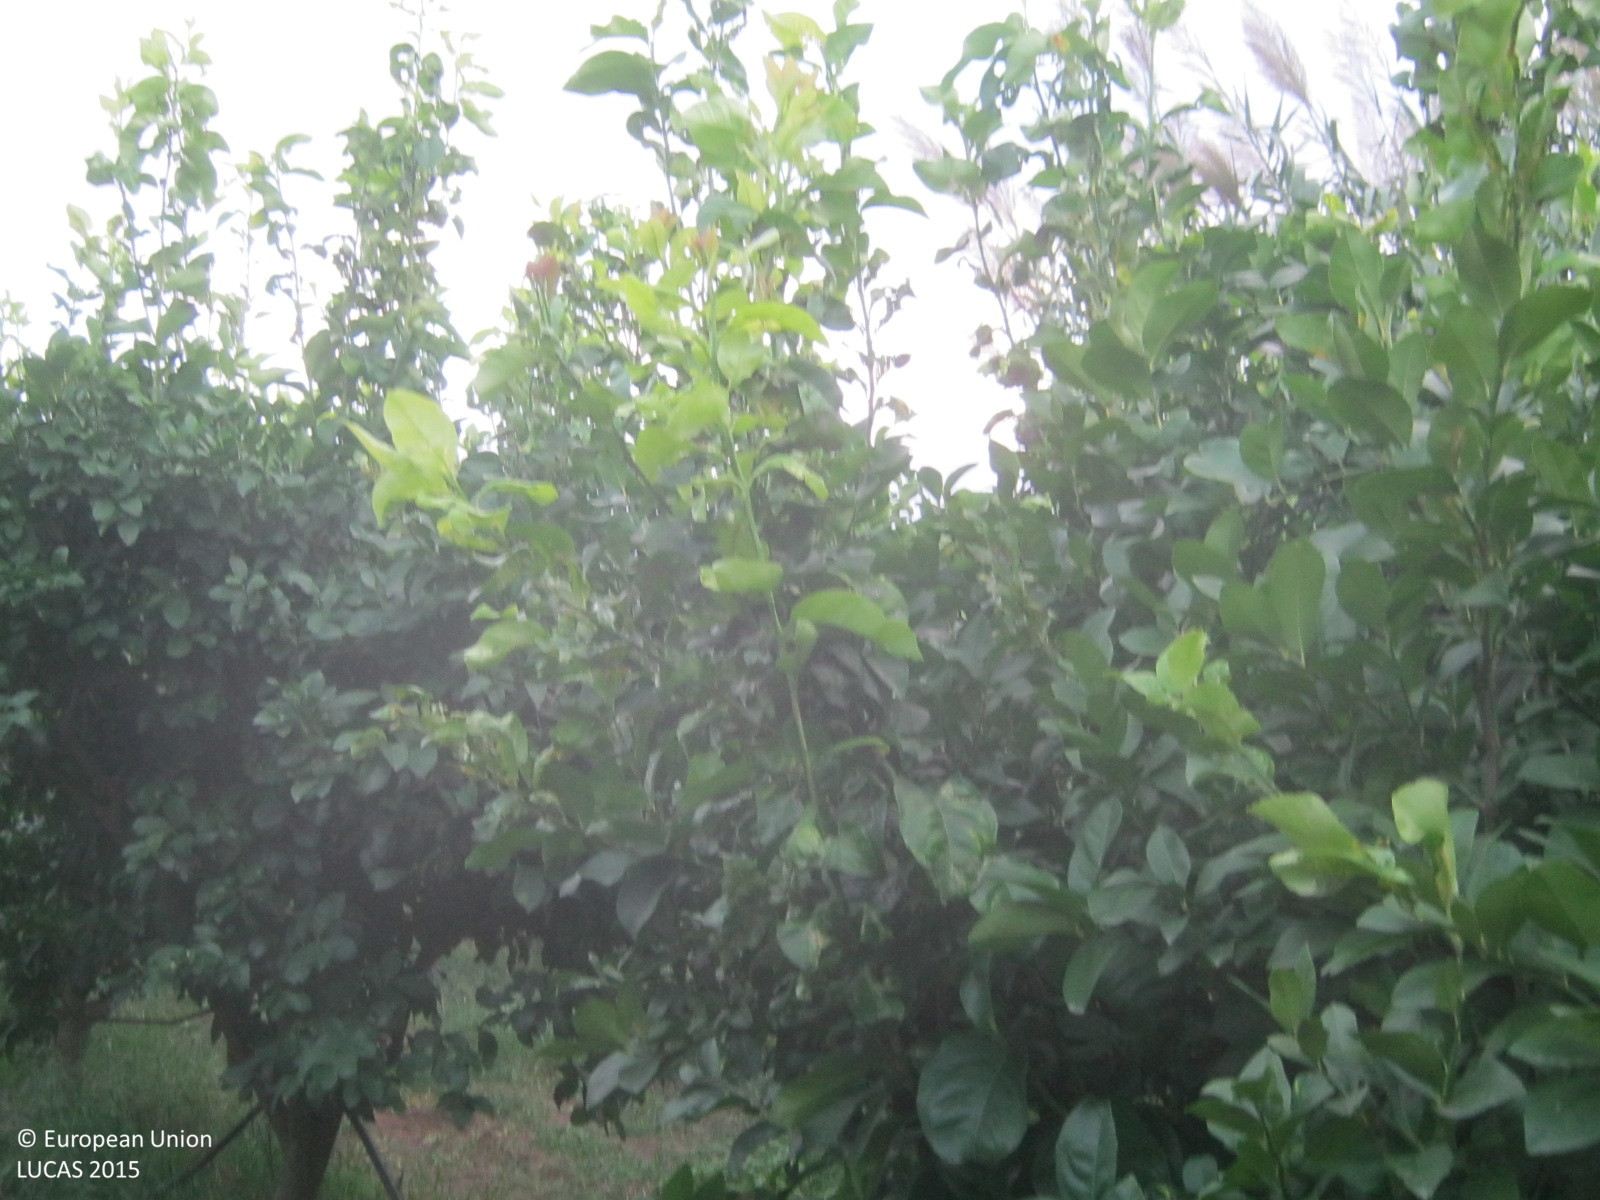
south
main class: Cropland
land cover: Other citrus fruit
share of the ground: 50 - 75 %
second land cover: Spontaneously vegetated surfaces
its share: > 75 %
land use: Agriculture (excluding fallow land and kitchen gardens)
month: September
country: GR
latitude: 38.2306
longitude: 22.1363
